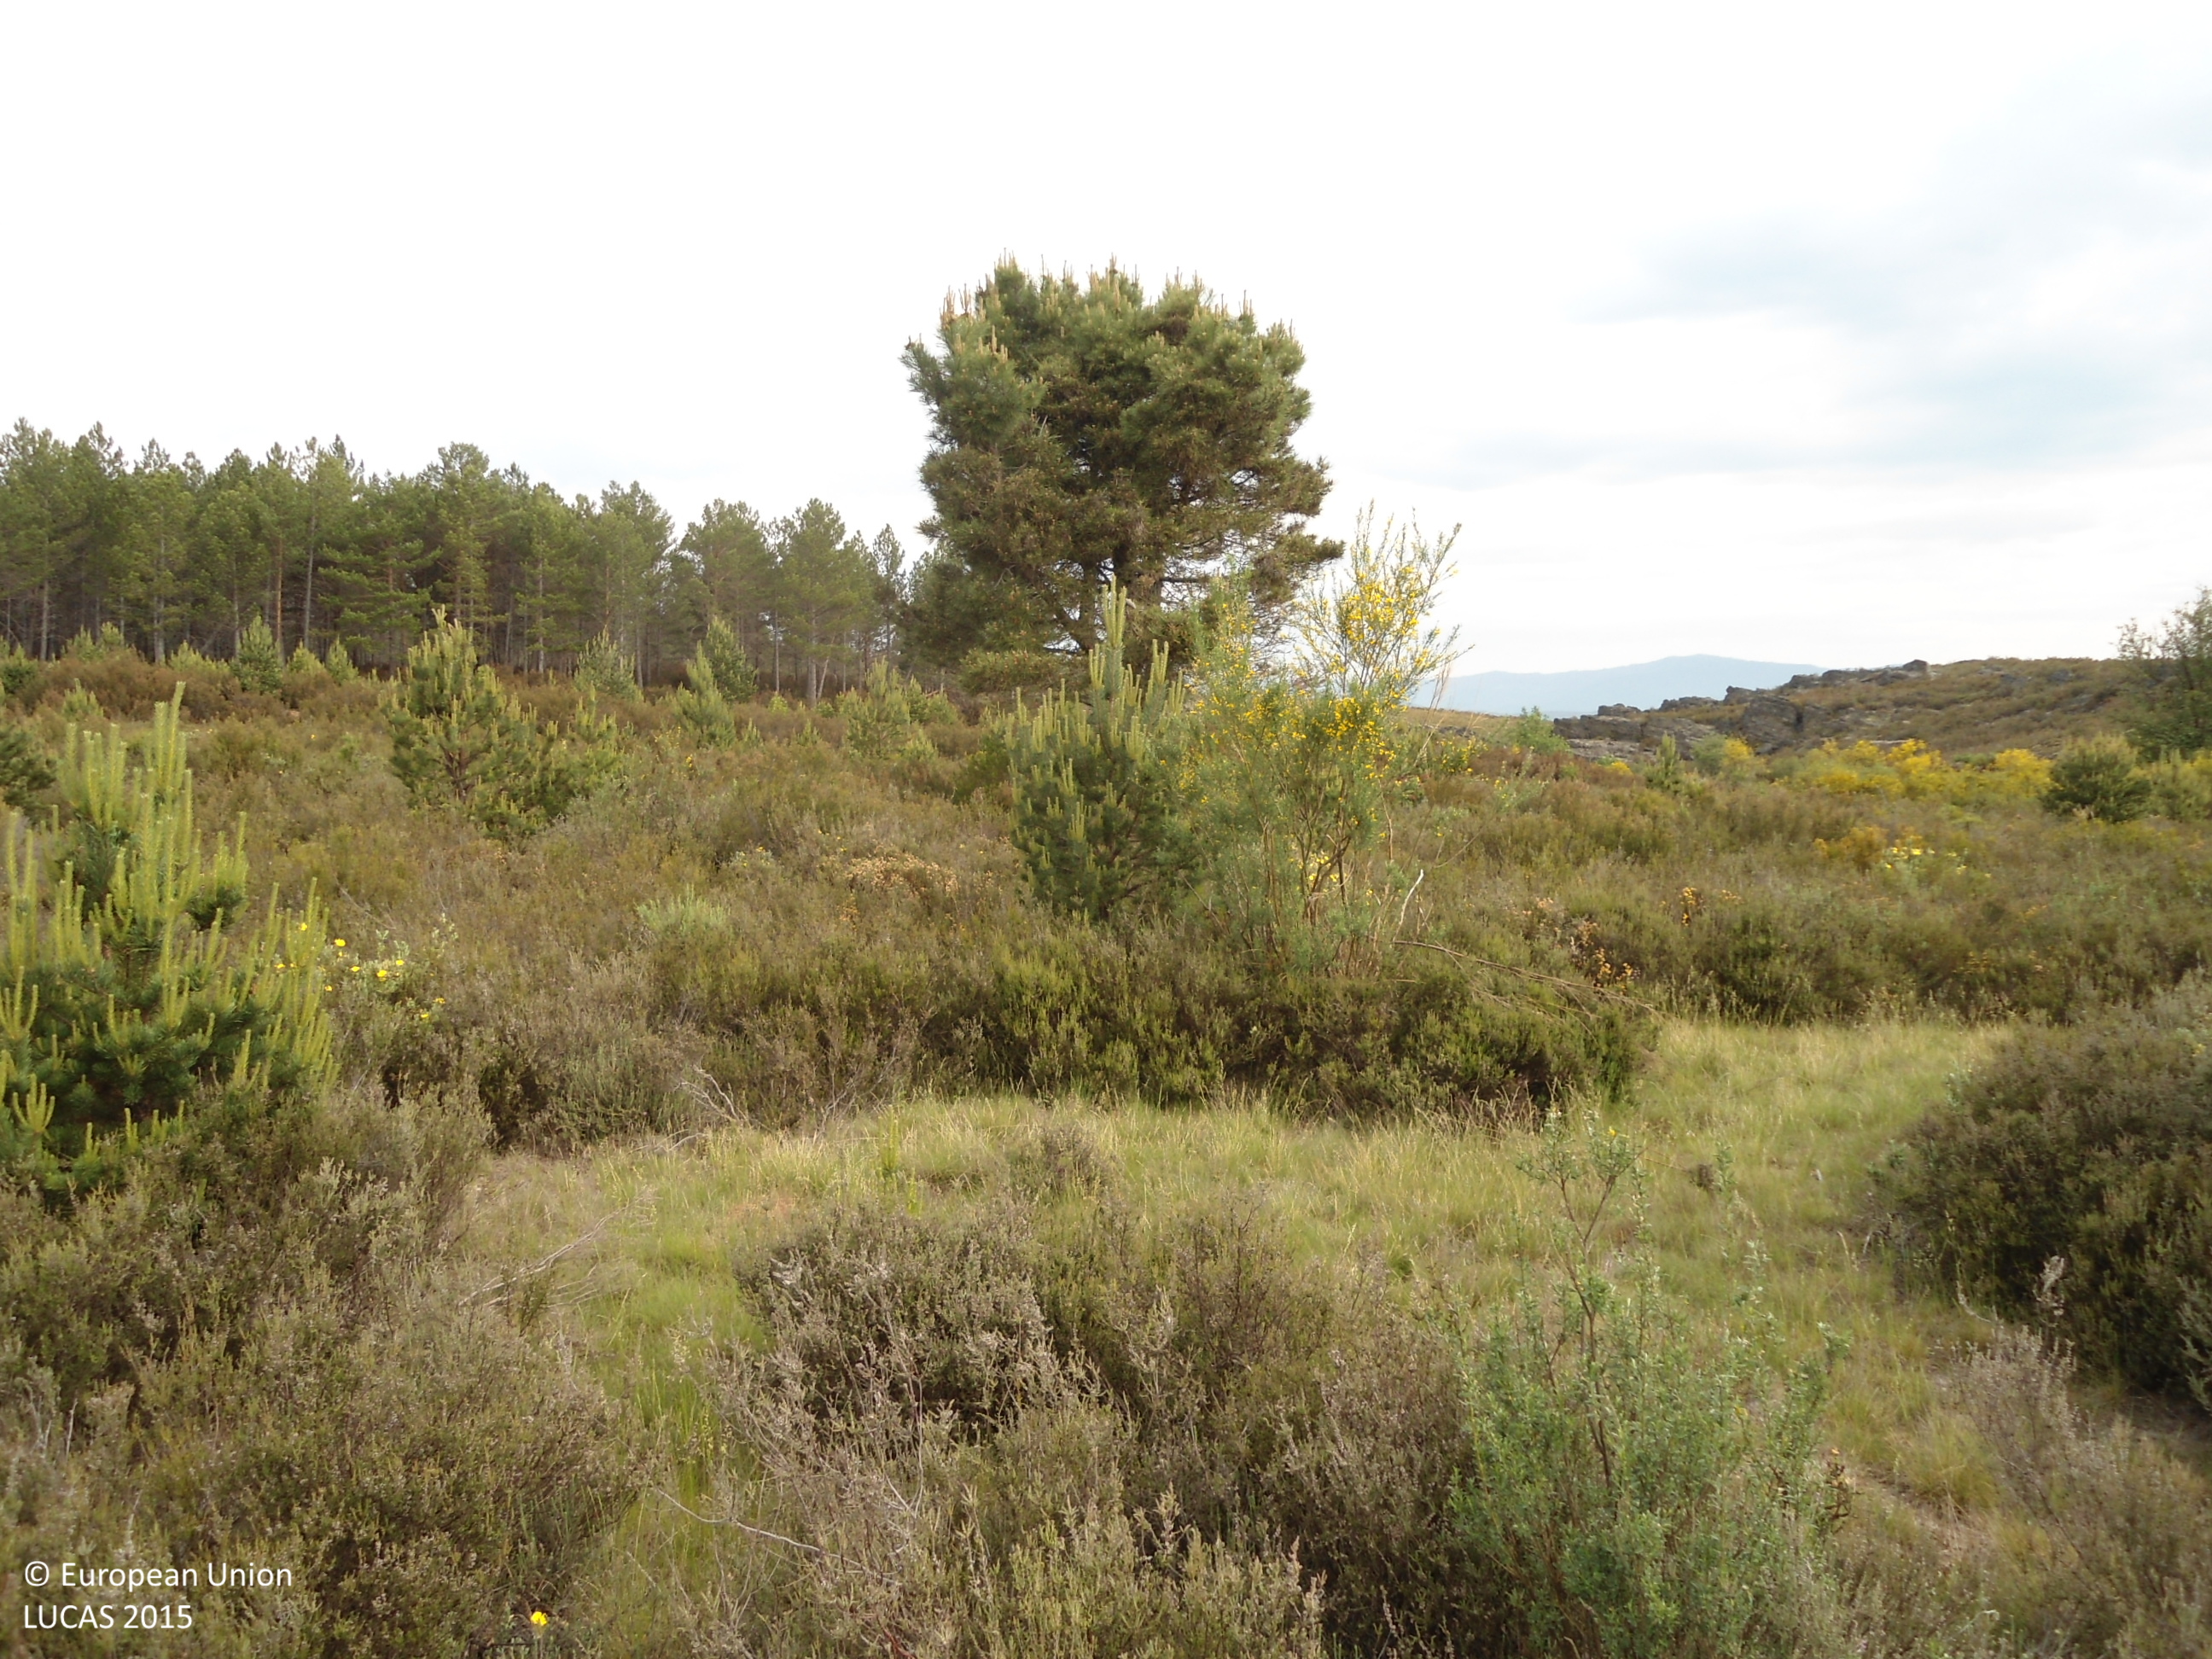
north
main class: Woodland
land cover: Pine dominated coniferous woodland
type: coniferous forest of the mediterranean region
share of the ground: 25 - 50 %
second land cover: Shrubland without tree cover
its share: 50 - 75 %
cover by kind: shrubs 70 %, coniferous forest trees 25 %, herbaceous plants 5 %
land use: Forestry
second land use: Community services
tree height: < 5 m
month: June
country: ES
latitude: 41.9827
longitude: -6.5371
